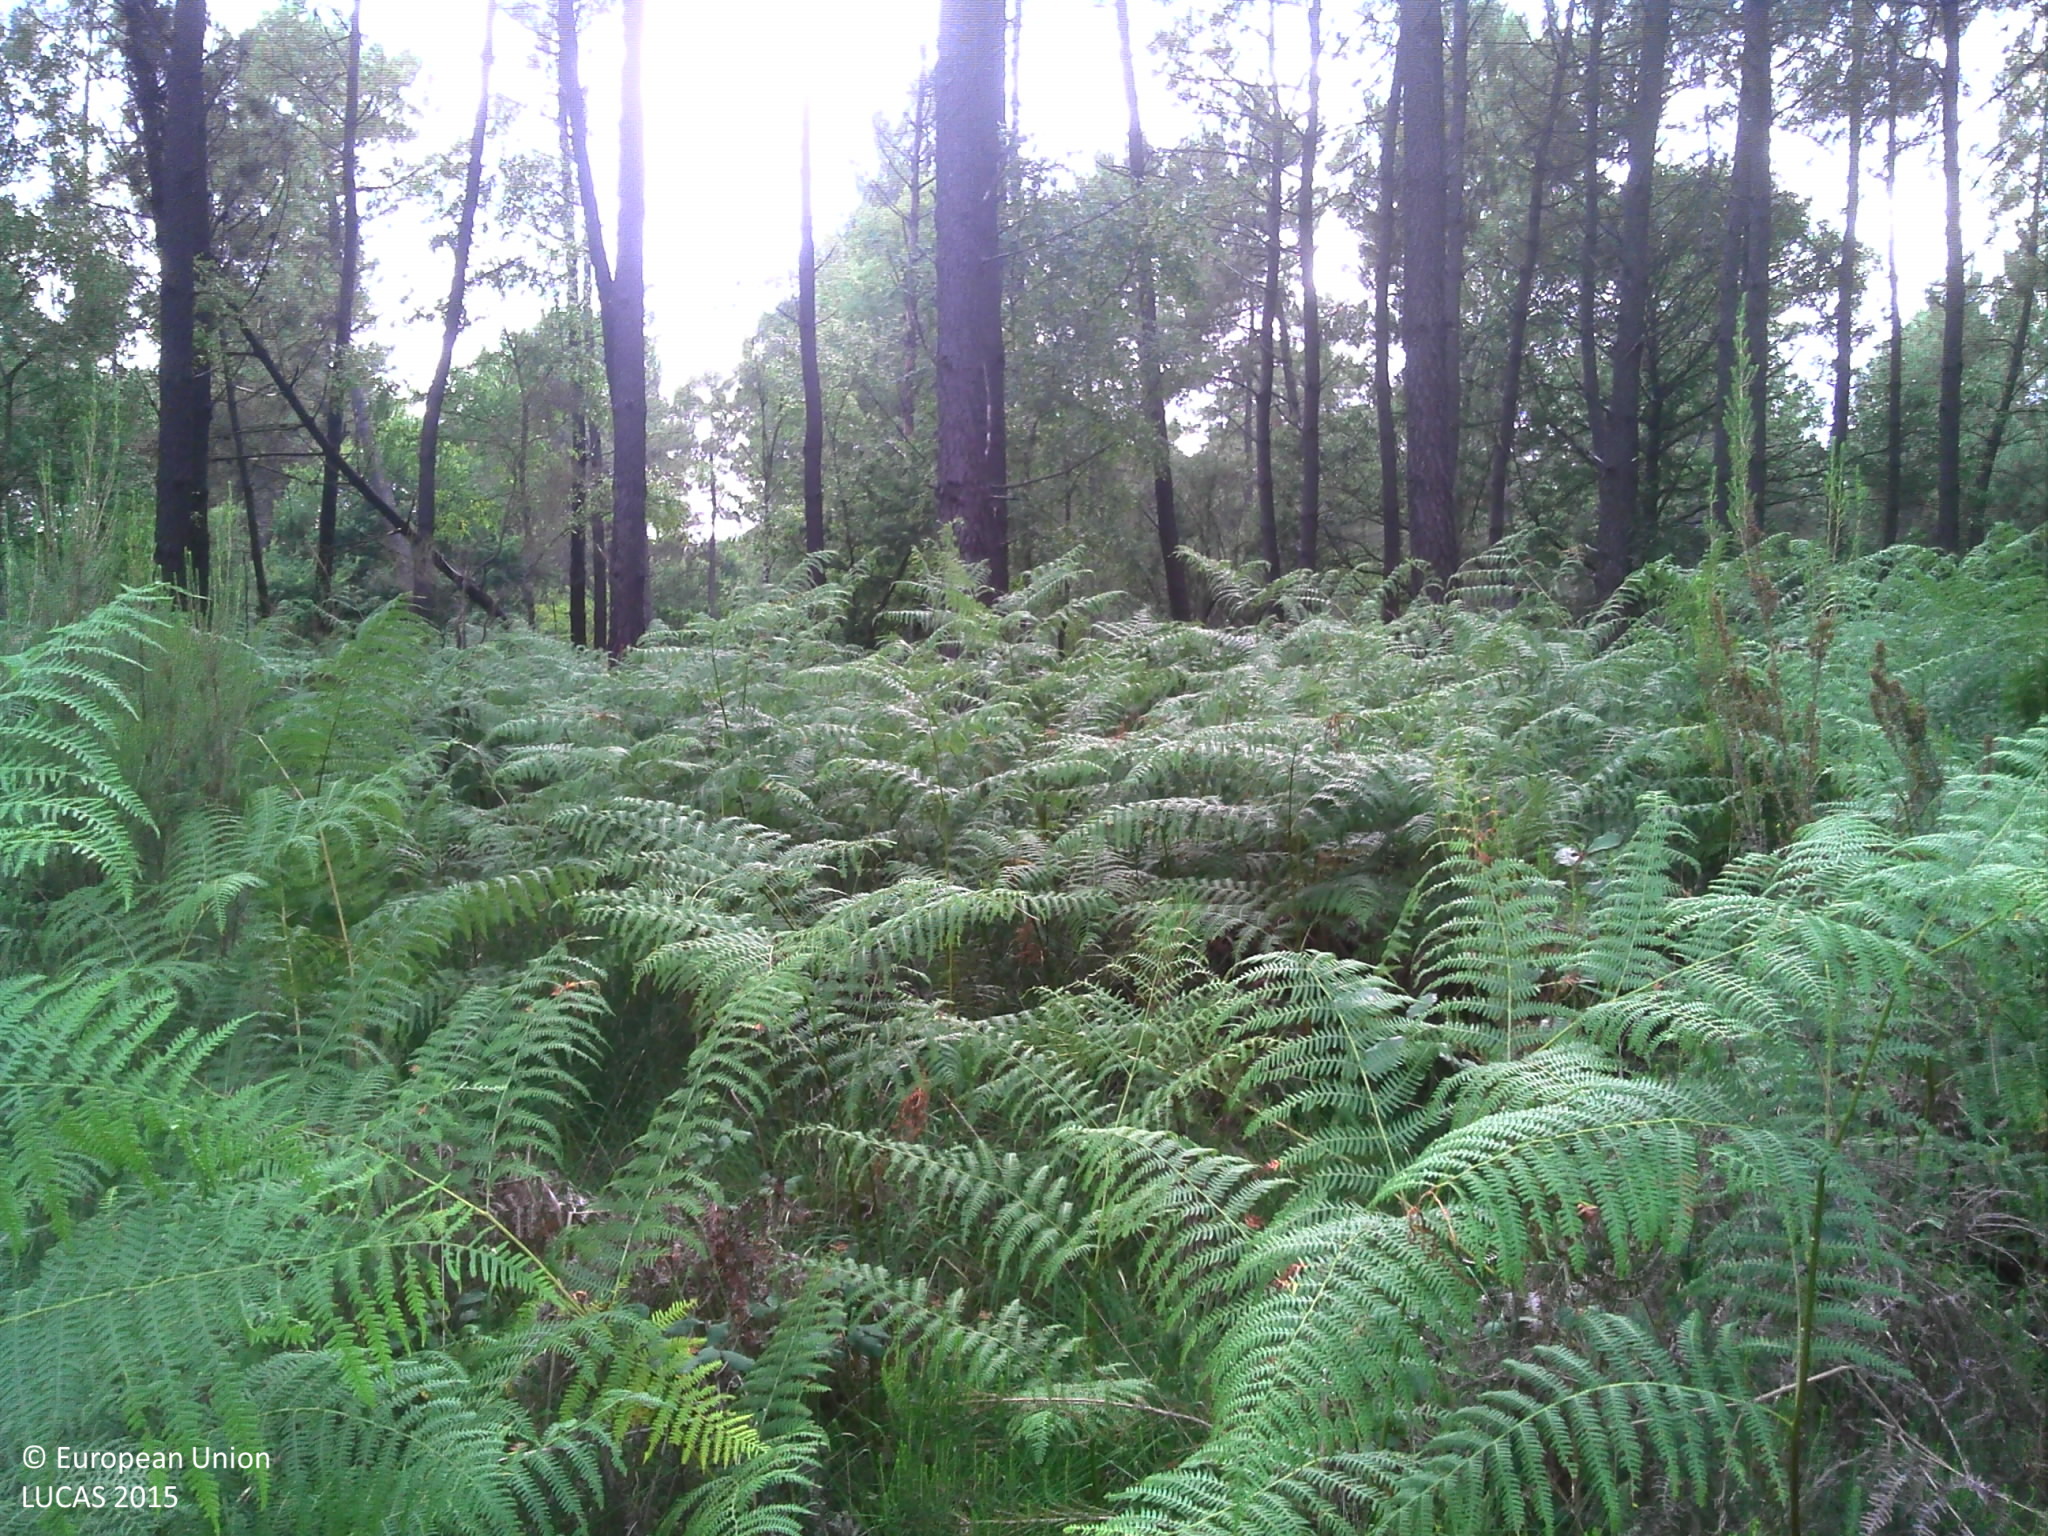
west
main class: Woodland
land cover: Pine dominated coniferous woodland
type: mesophytic deciduous forest
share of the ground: > 75 %
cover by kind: coniferous forest trees 65 %, broadleaved forest trees 10 %, shrubs 10 %, herbaceous plants 10 %, lichens and mosses 5 %
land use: Forestry
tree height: > 5 m
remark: Fire break
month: July
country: FR
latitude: 47.2017
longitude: 0.3551
